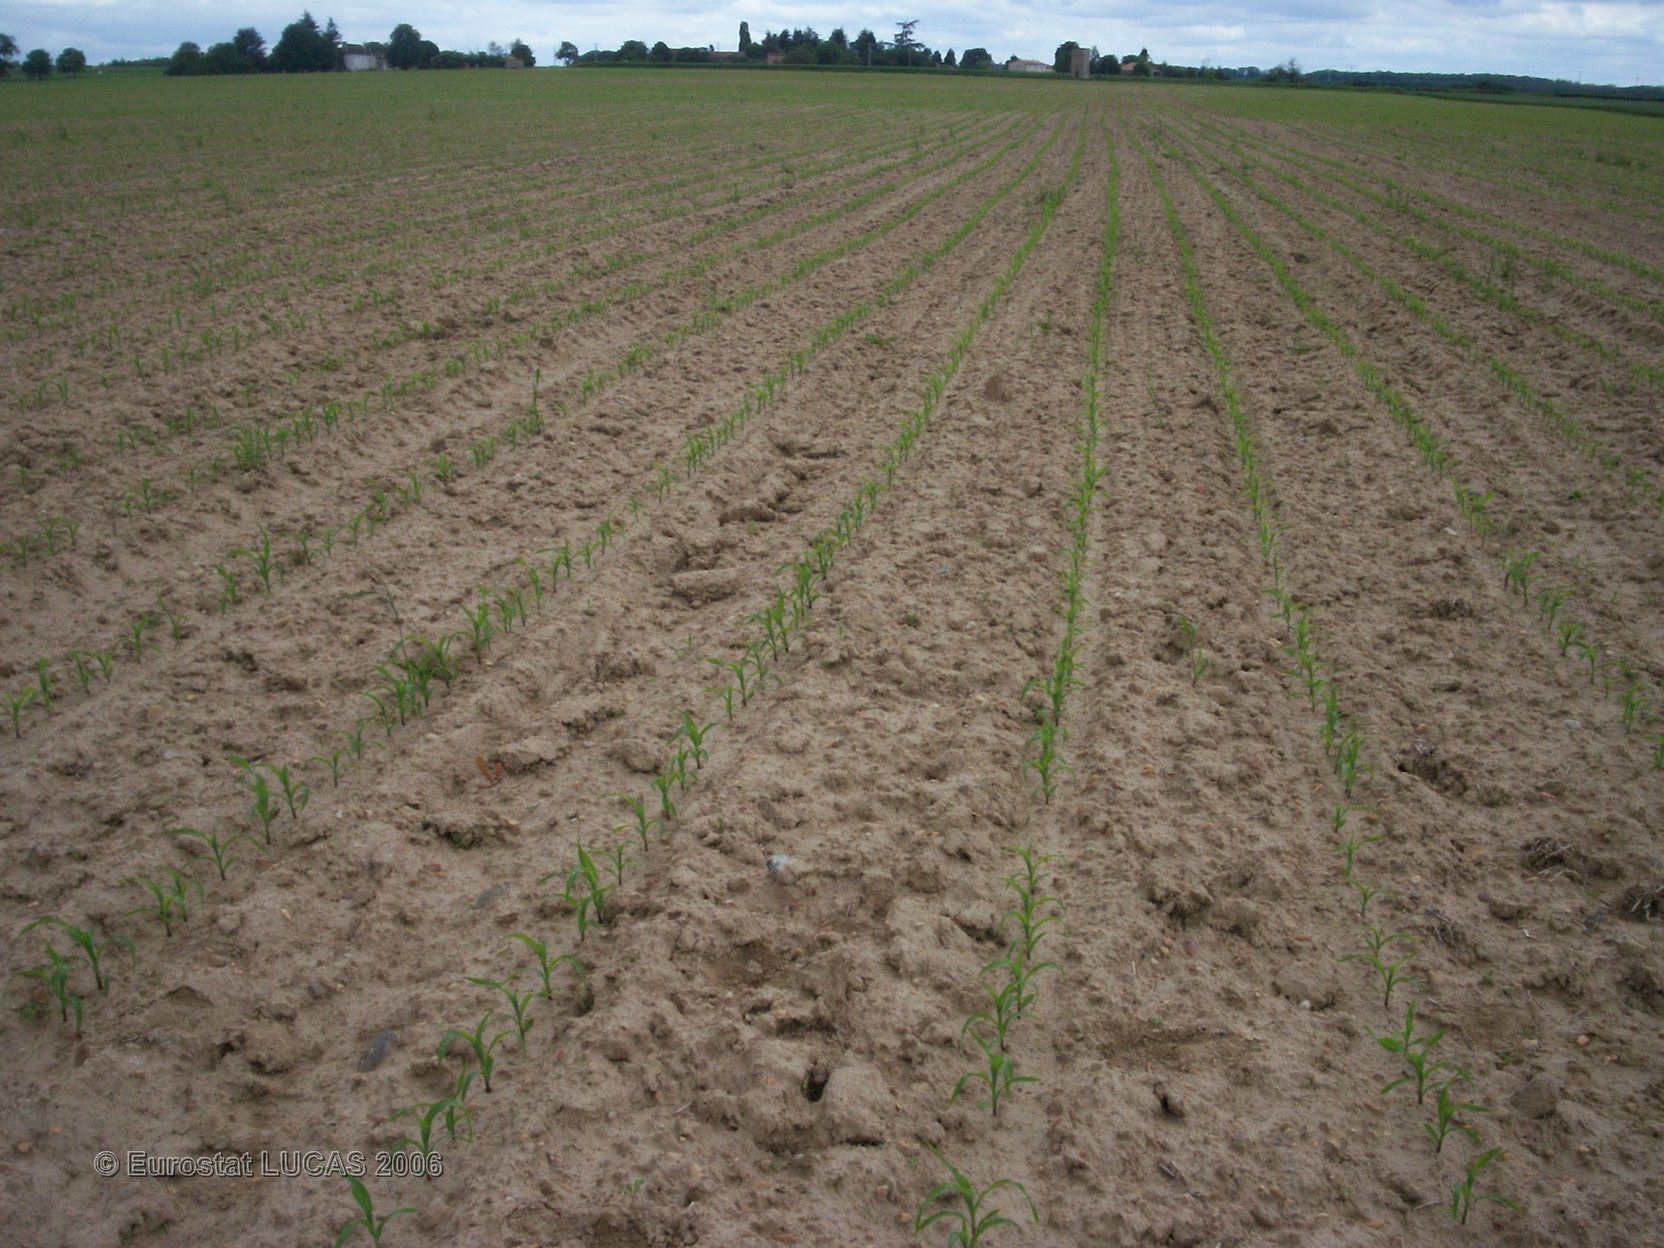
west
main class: Cropland
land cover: Maize
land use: Agriculture (excluding fallow land and kitchen gardens)
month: May
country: FR
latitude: 46.6401
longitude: 0.5635
